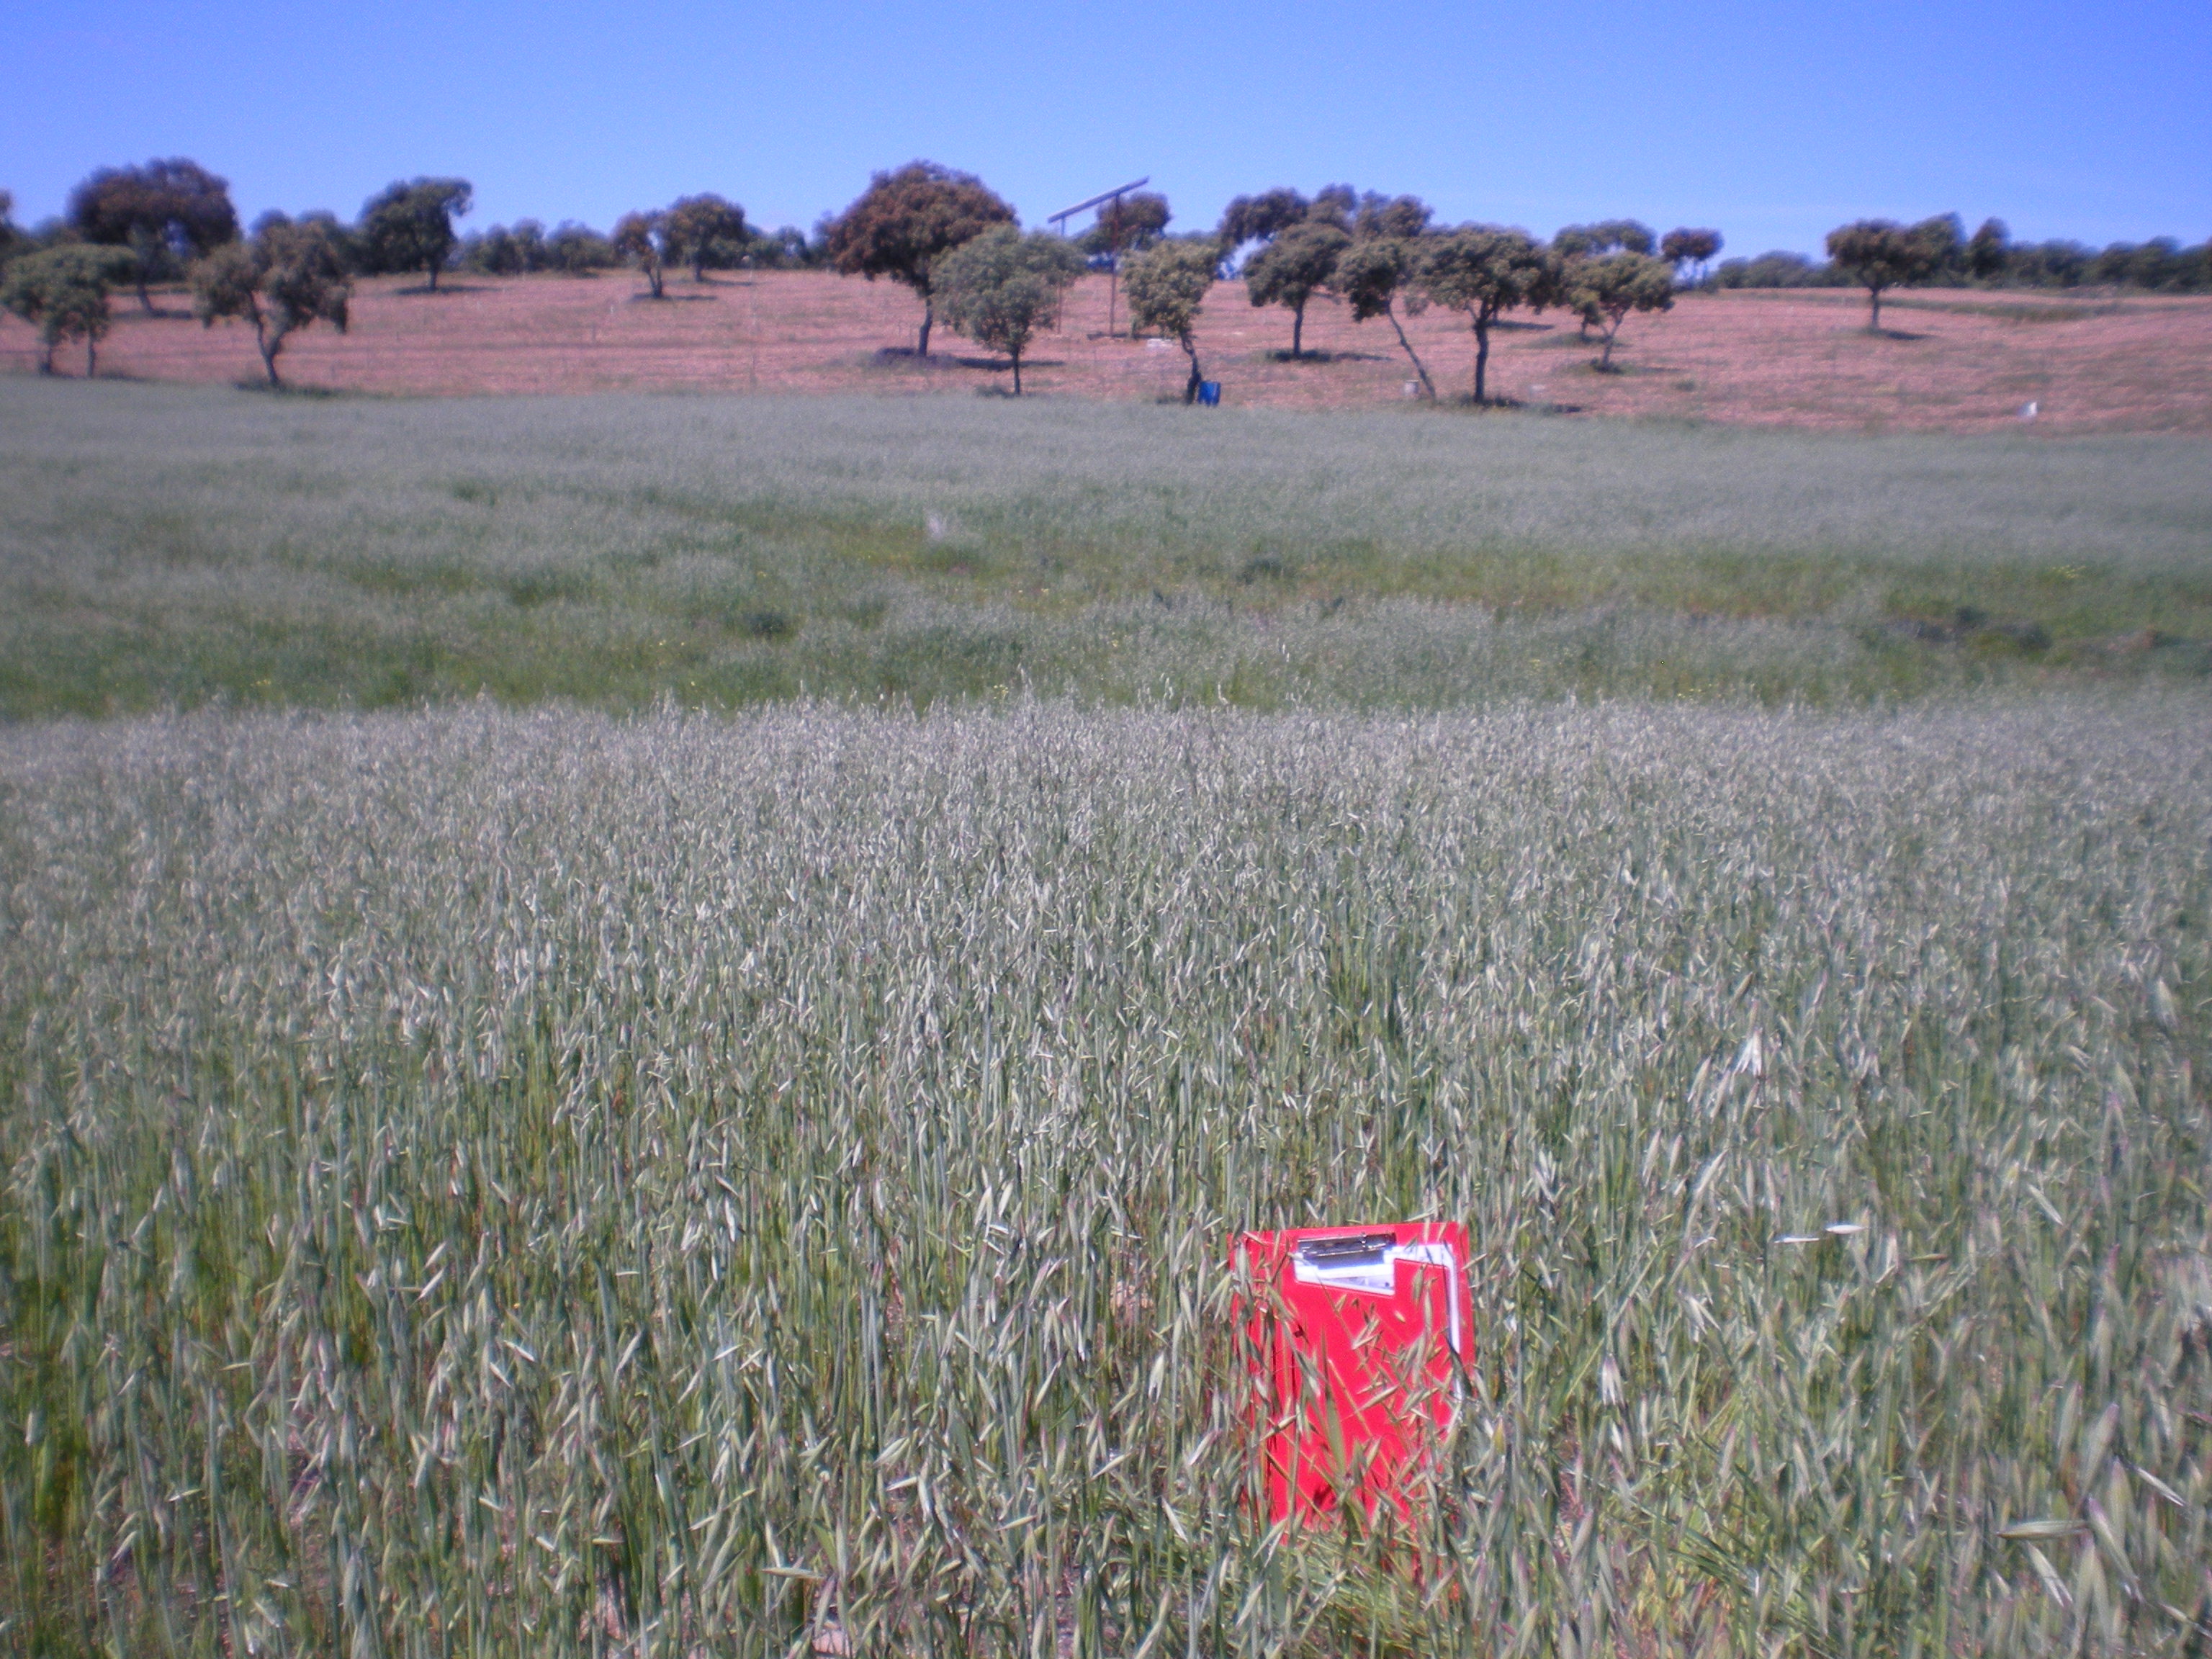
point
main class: Cropland
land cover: Oats
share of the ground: > 75 %
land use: Agriculture (excluding fallow land and kitchen gardens)
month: April
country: ES
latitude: 38.5079
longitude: -2.9500
